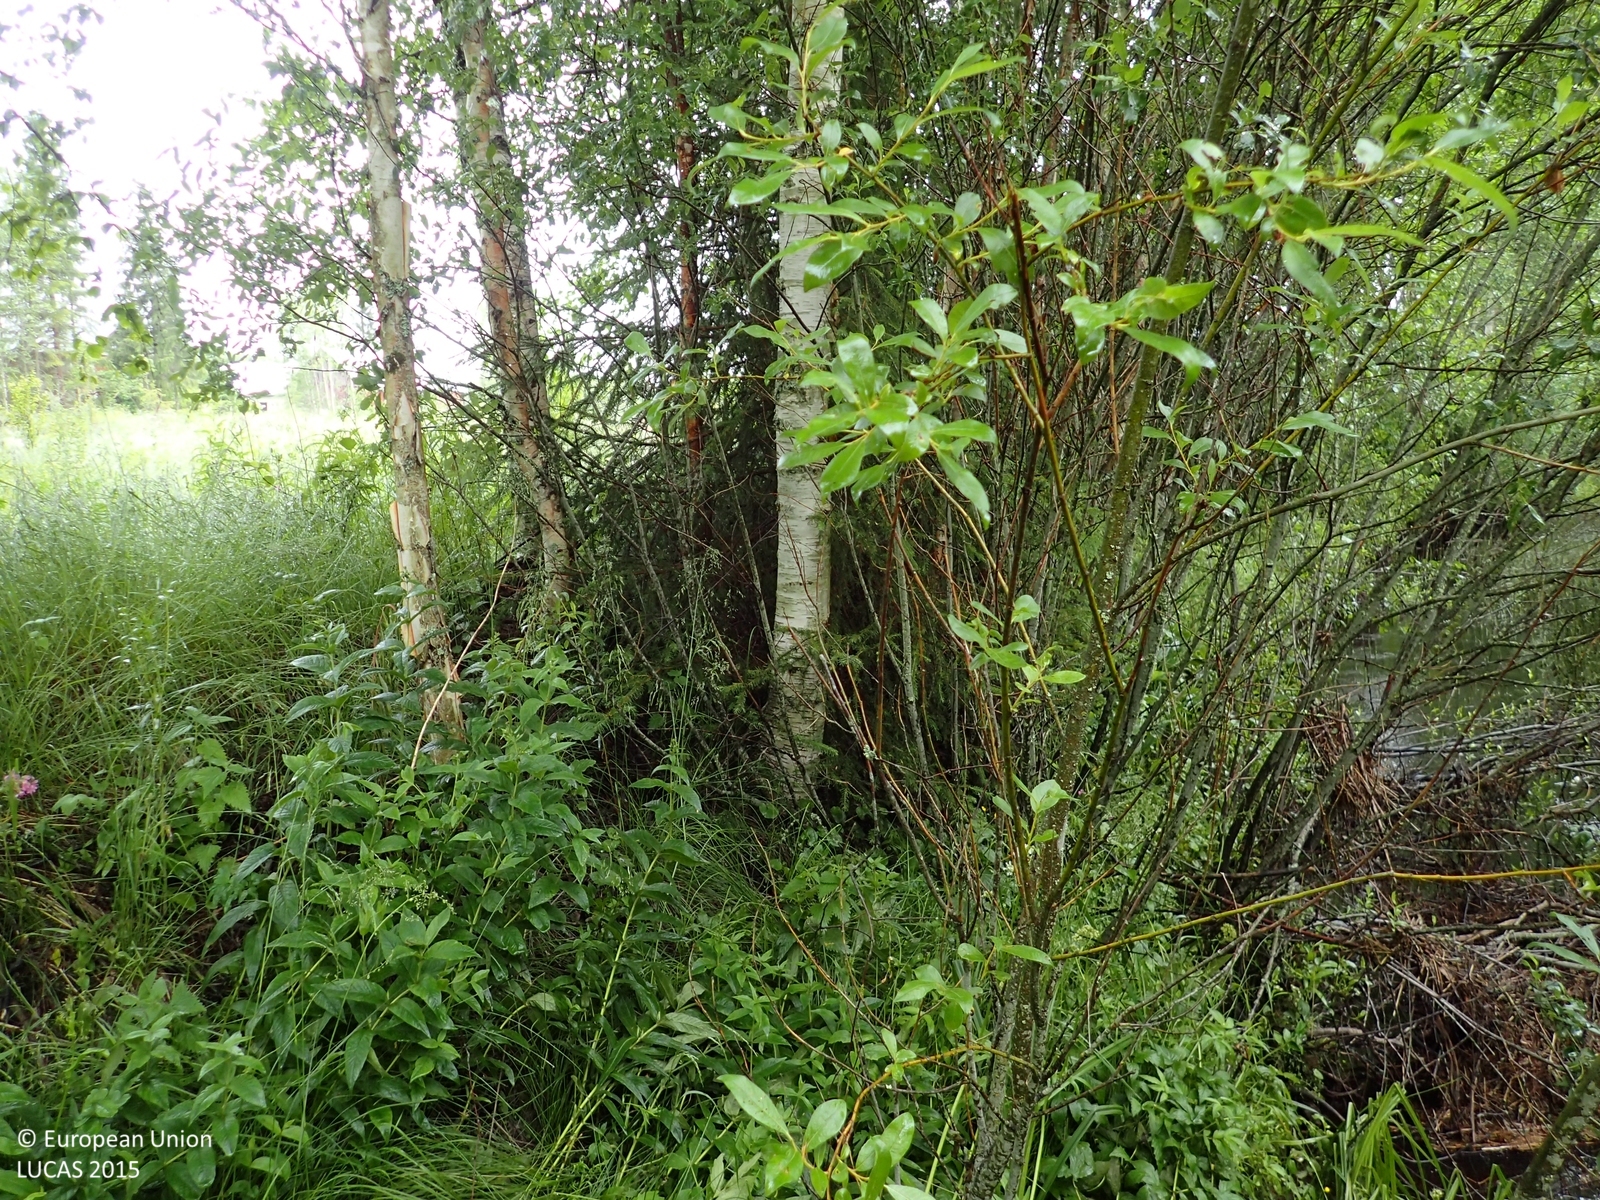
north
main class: Woodland
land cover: Spruce dominated mixed woodland
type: boreal forest
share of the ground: 50 - 75 %
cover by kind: broadleaved forest trees 55 %, shrubs 25 %, coniferous forest trees 20 %
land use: Forestry
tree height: > 5 m
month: July
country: FI
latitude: 62.8642
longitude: 21.7364
